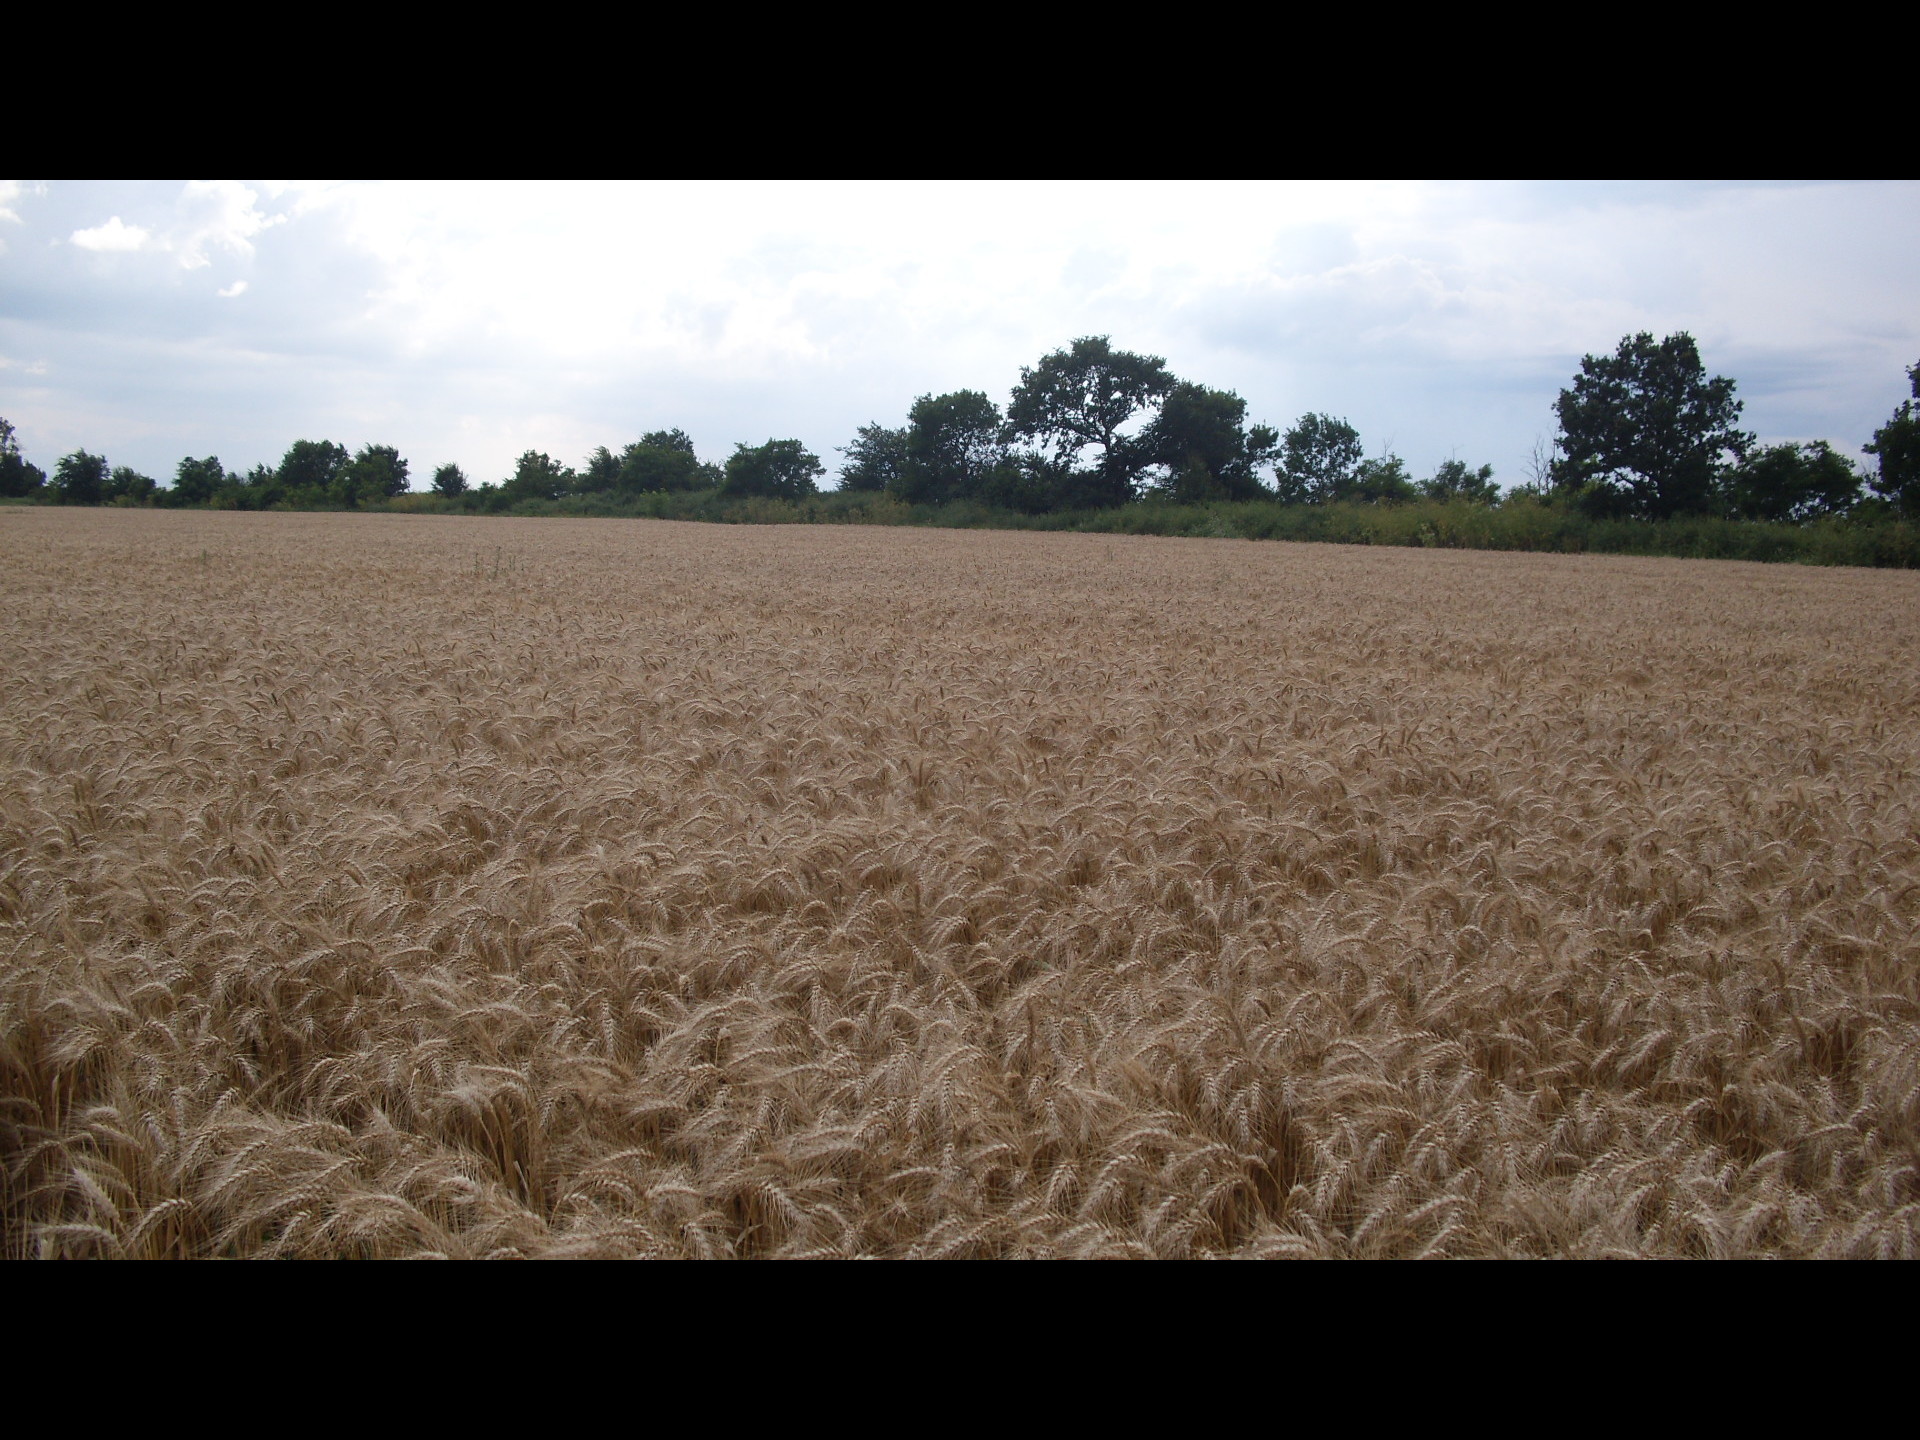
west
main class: Cropland
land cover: Common wheat
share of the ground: 10 - 25 %
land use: Agriculture (excluding fallow land and kitchen gardens)
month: June
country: BG
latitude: 43.5647
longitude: 23.4276
